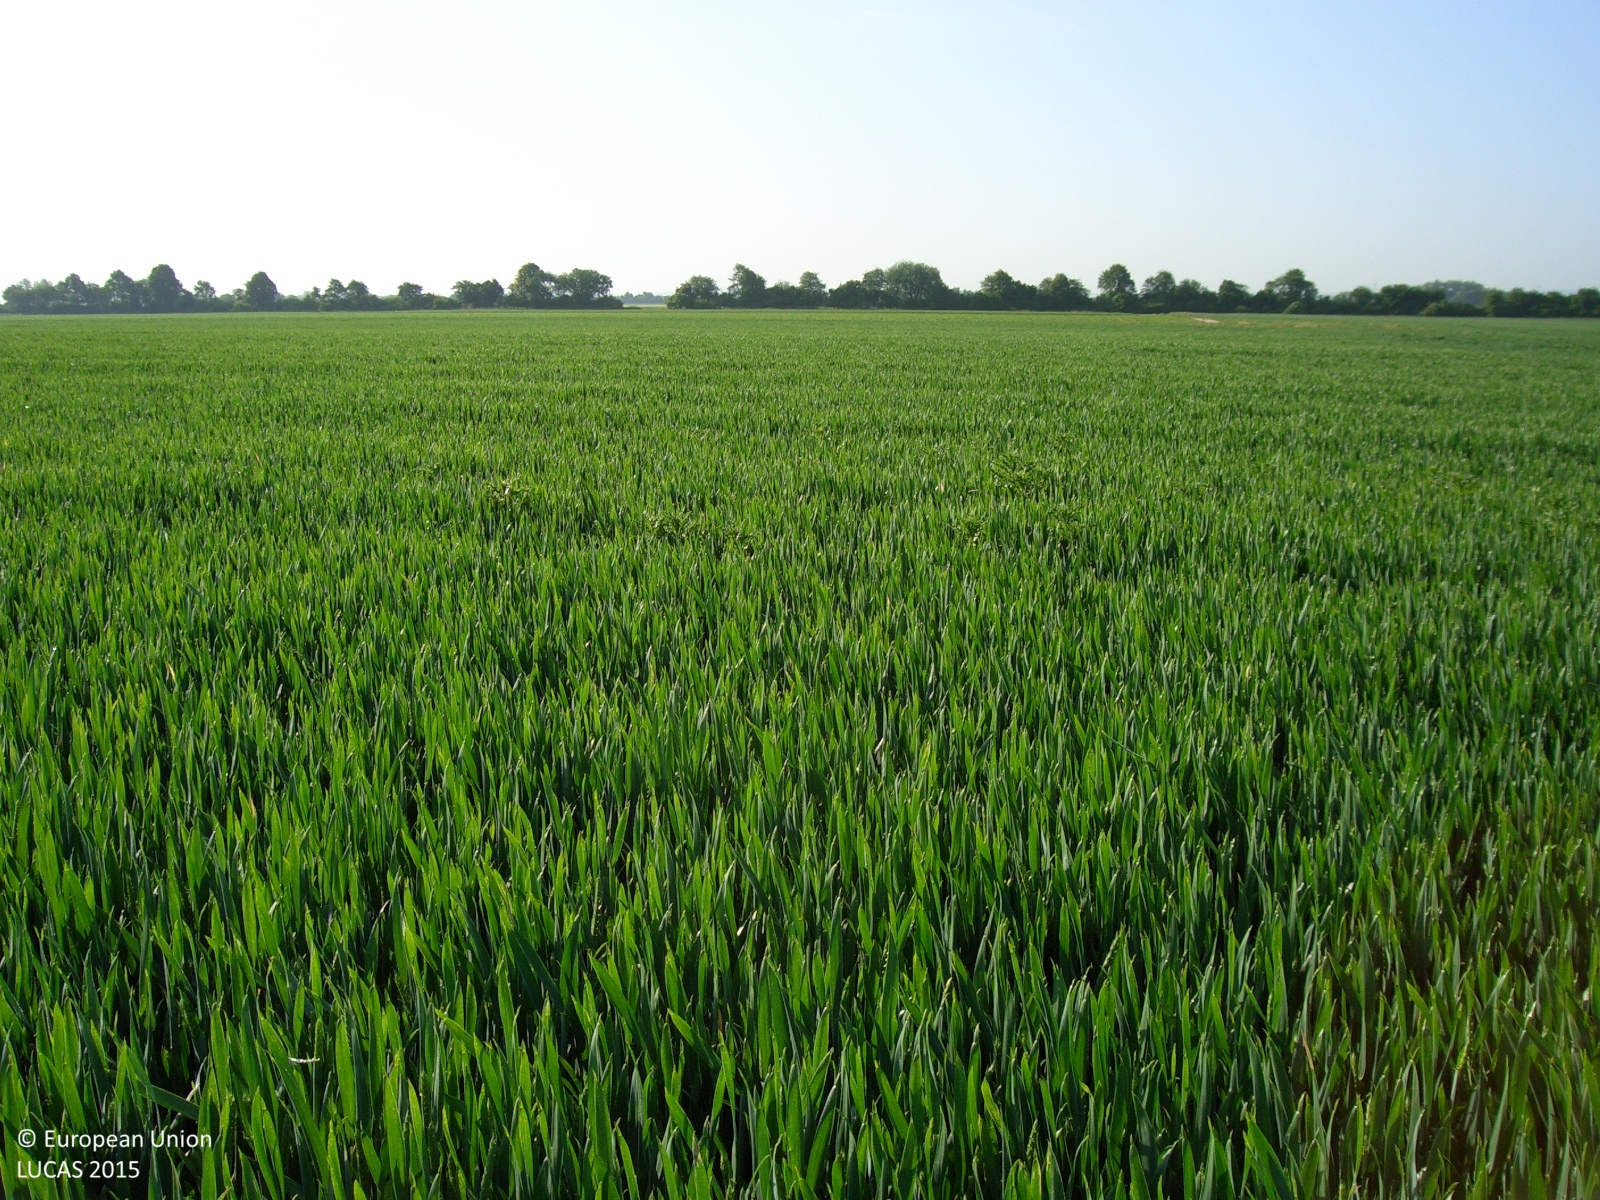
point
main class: Cropland
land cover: Common wheat
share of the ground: > 75 %
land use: Agriculture (excluding fallow land and kitchen gardens)
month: June
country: DE
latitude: 50.8601
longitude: 6.2344
